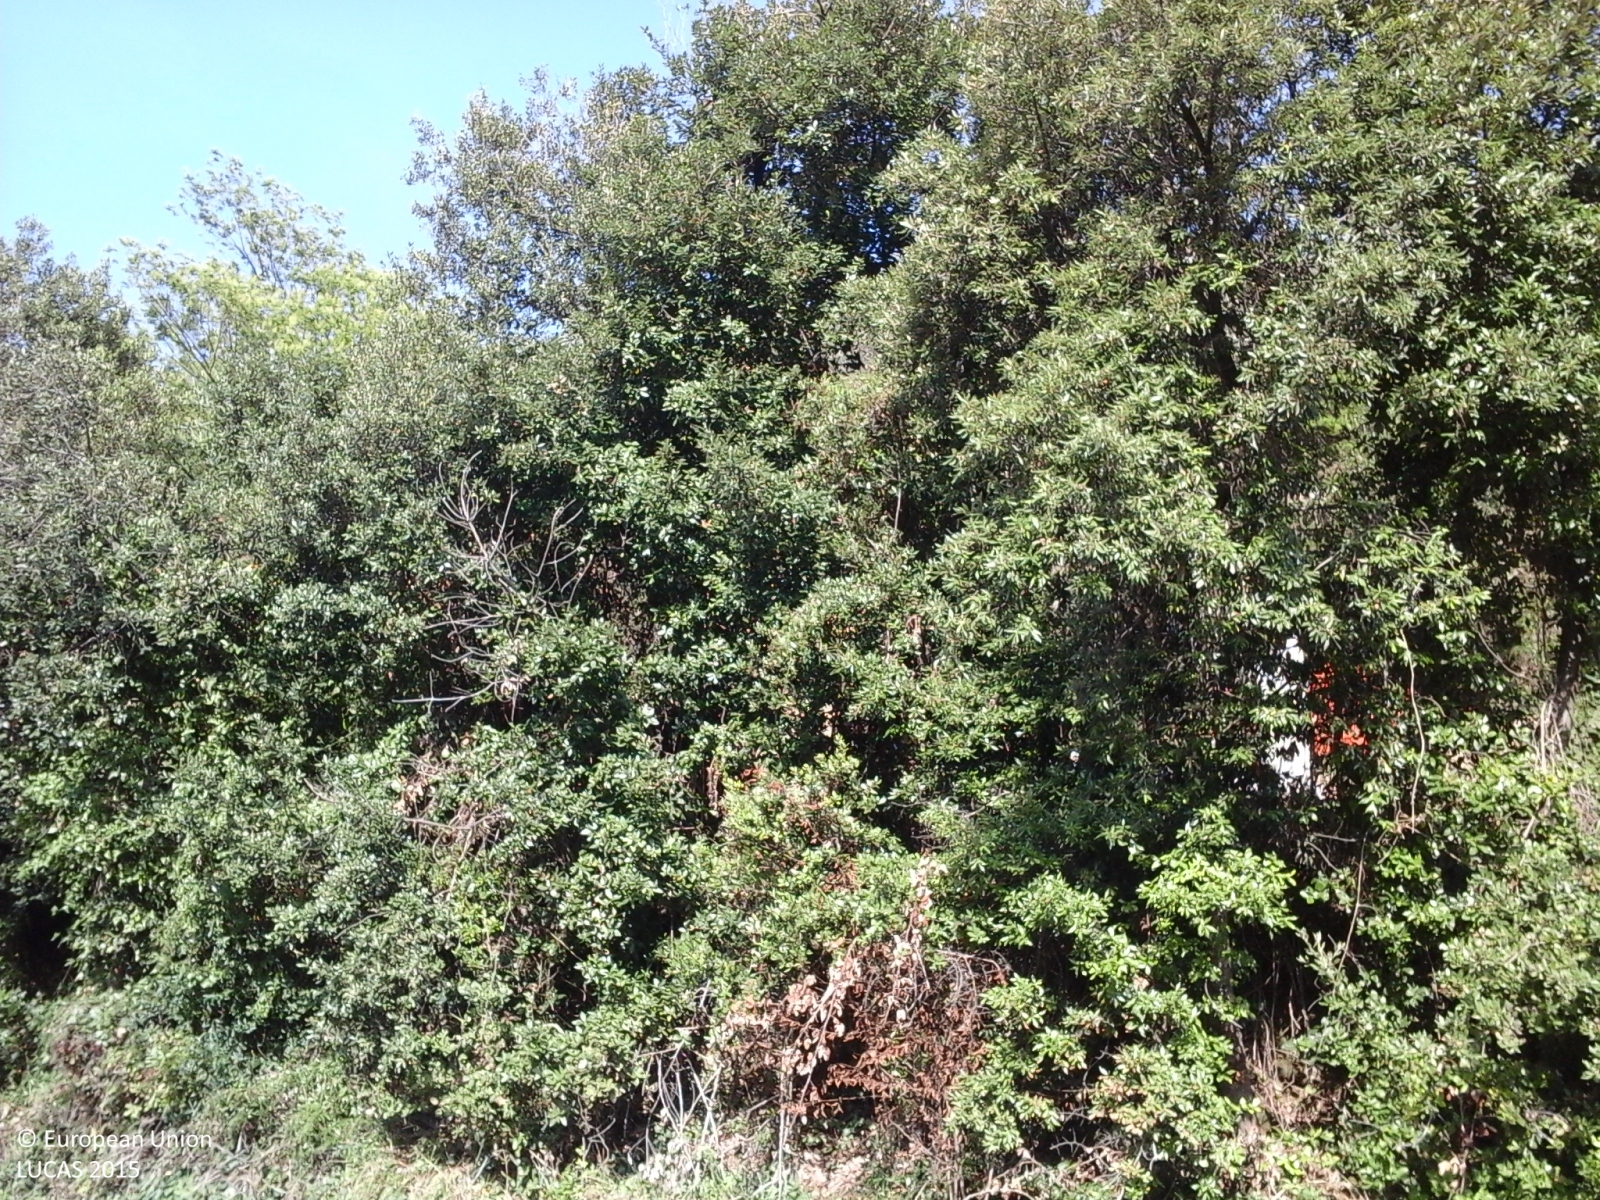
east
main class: Woodland
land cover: Broadleaved woodland
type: thermophilous deciduous forest
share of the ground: > 75 %
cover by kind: broadleaved forest trees 80 %, shrubs 20 %
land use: Forestry
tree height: > 5 m
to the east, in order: Broadleaved woodland; Paved roads, cycling and walking lanes; Artificial constructions; Tracks; Broadleaved woodland; Dry stone walls; Olive groves; Dry stone walls; Olive groves; Dry stone walls; Olive groves; Dry stone walls; Olive groves; Dry stone walls; Other mixed woodland; Dry stone walls; Floriculture and ornamental plants; Dry stone walls; Floriculture and ornamental plants; Dry stone walls; Floriculture and ornamental plants; Pine dominated mixed woodland; Paved roads, cycling and walking lanes; Pine dominated mixed woodland
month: October
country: IT
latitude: 43.8165
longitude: 7.5567
